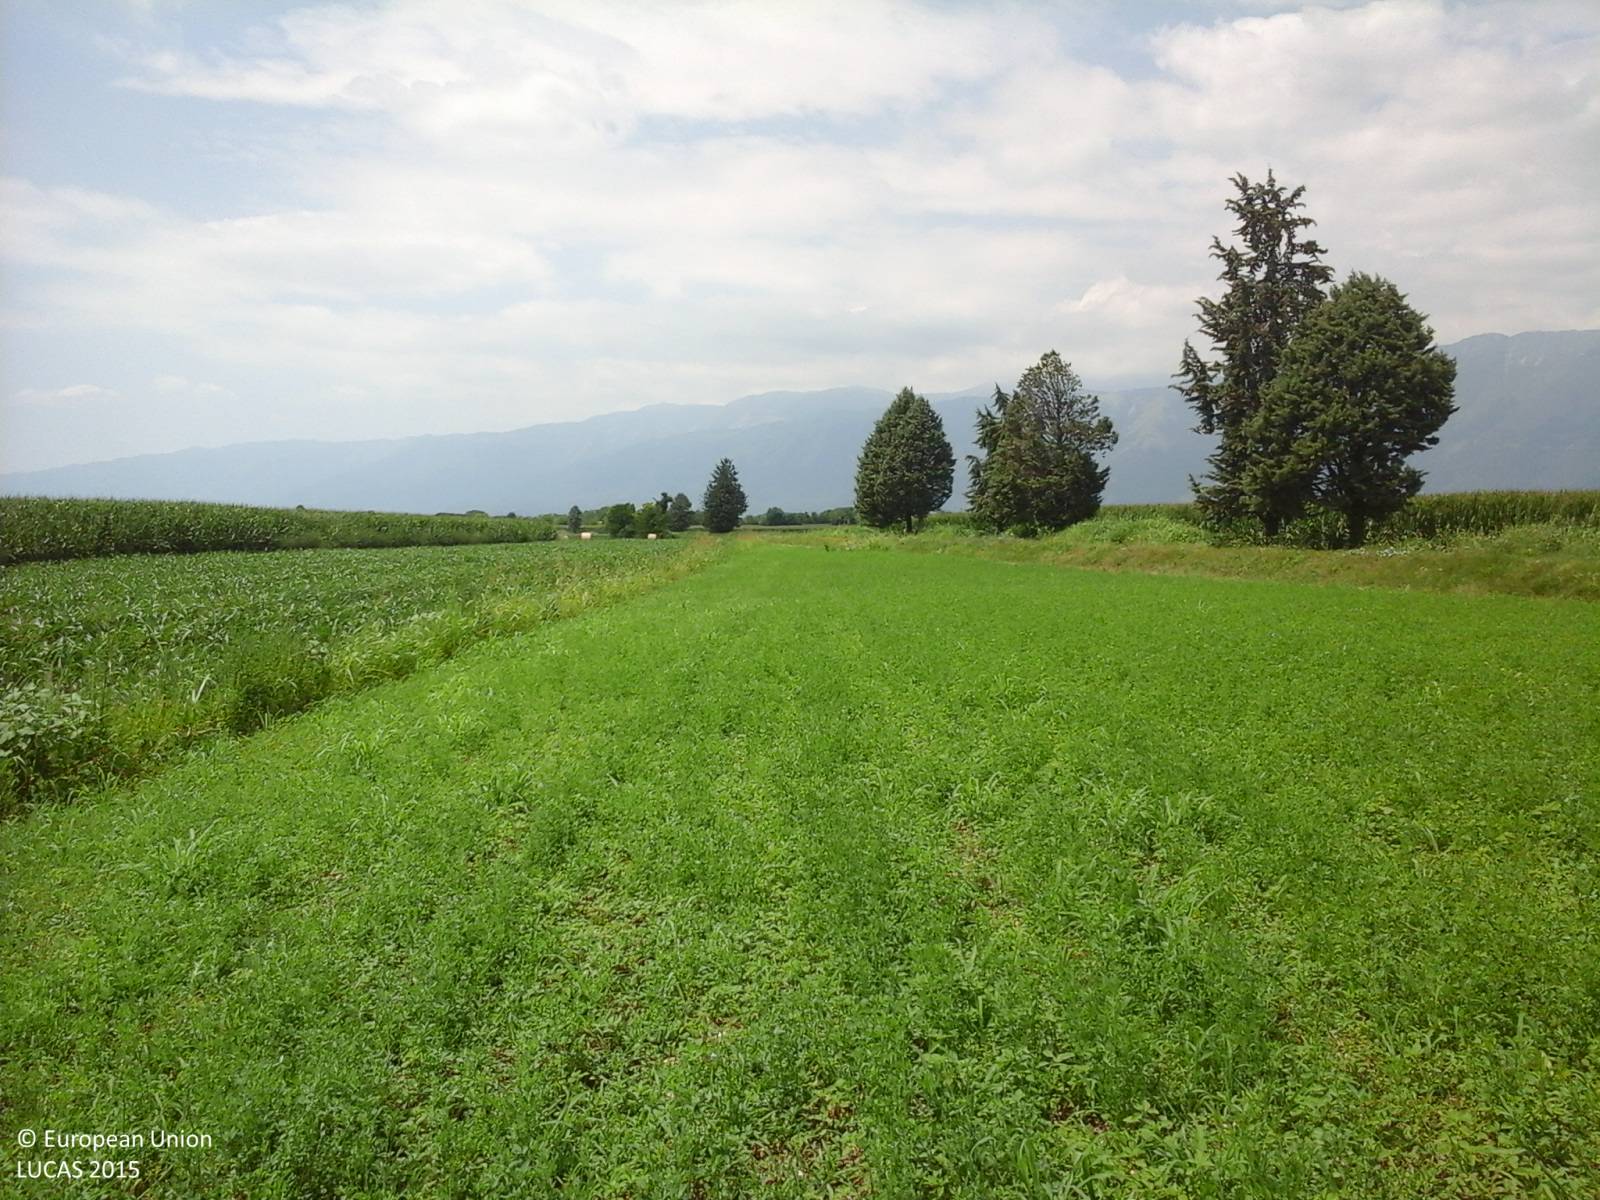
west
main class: Cropland
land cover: Lucerne
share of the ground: > 75 %
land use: Agriculture (excluding fallow land and kitchen gardens)
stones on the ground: 25 - 50 %
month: July
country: IT
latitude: 46.0829
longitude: 12.6995
